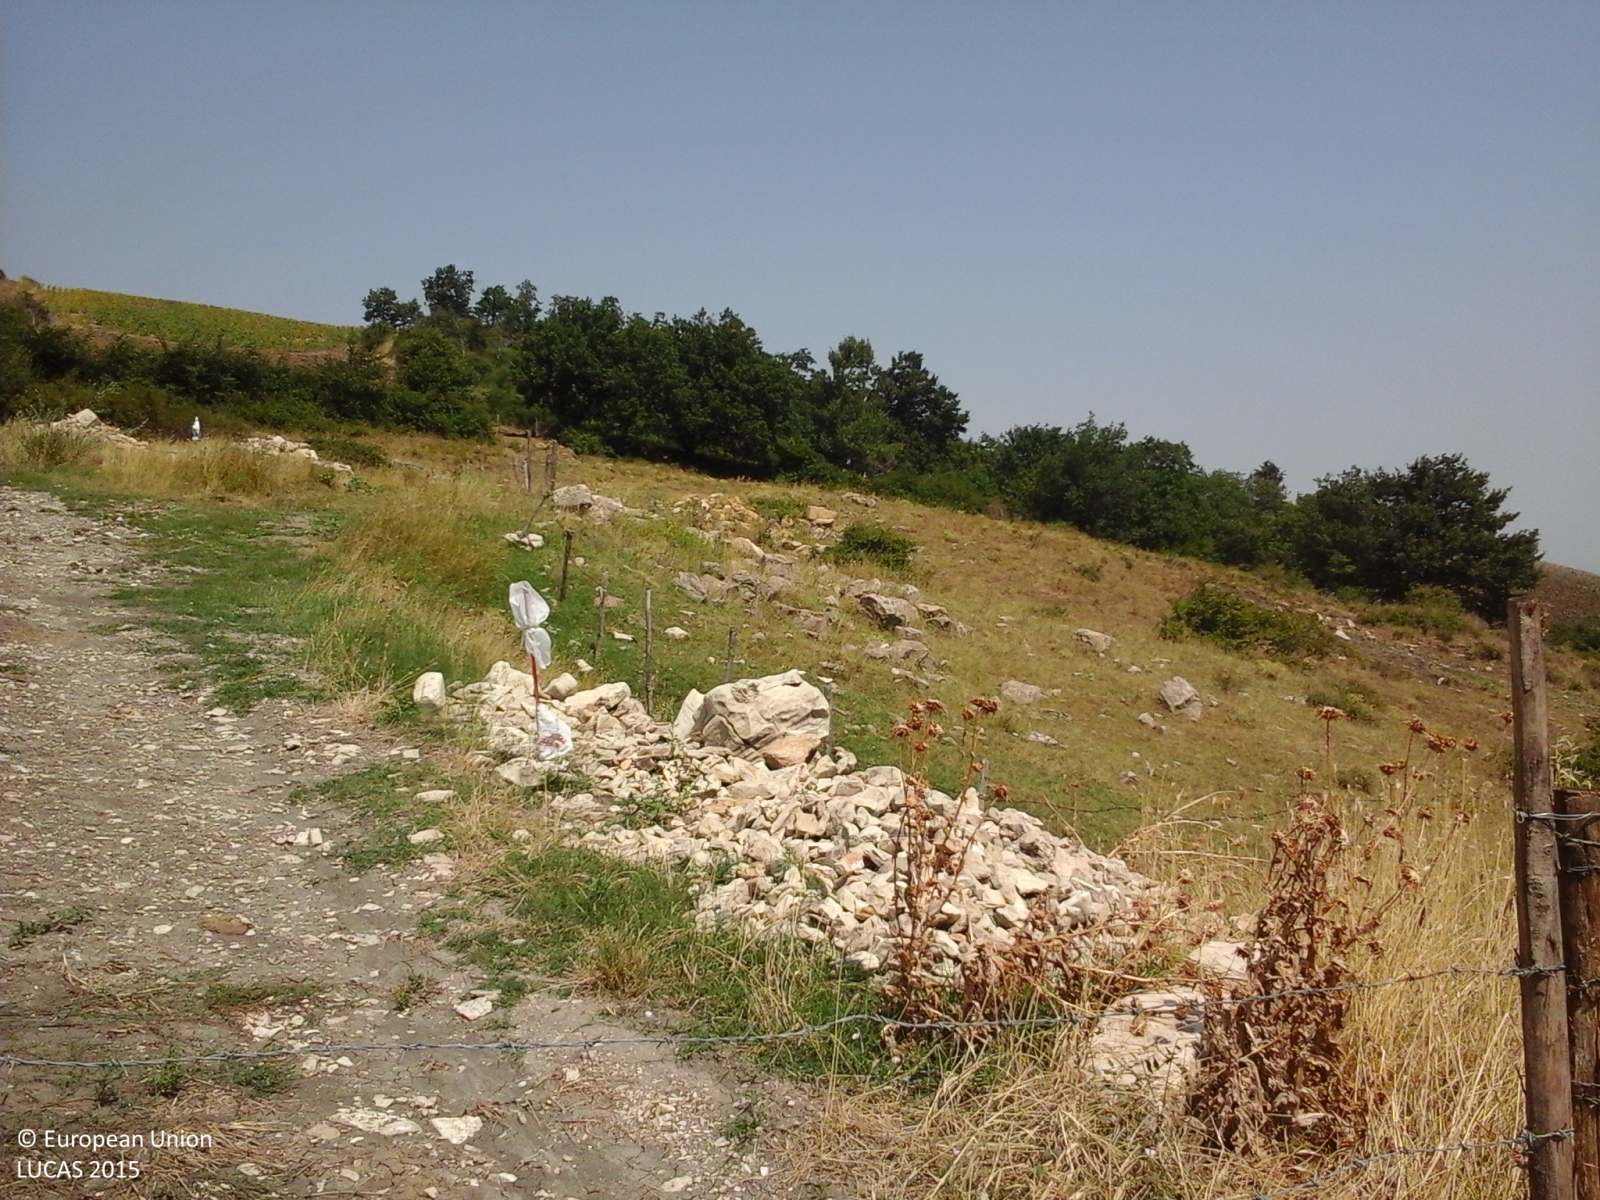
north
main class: Shrubland
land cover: Shrubland with sparse tree cover
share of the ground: > 75 %
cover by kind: shrubs 95 %, broadleaved forest trees 5 %
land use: Abandoned areas
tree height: > 5 m
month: August
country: IT
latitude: 41.3627
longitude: 15.1821
